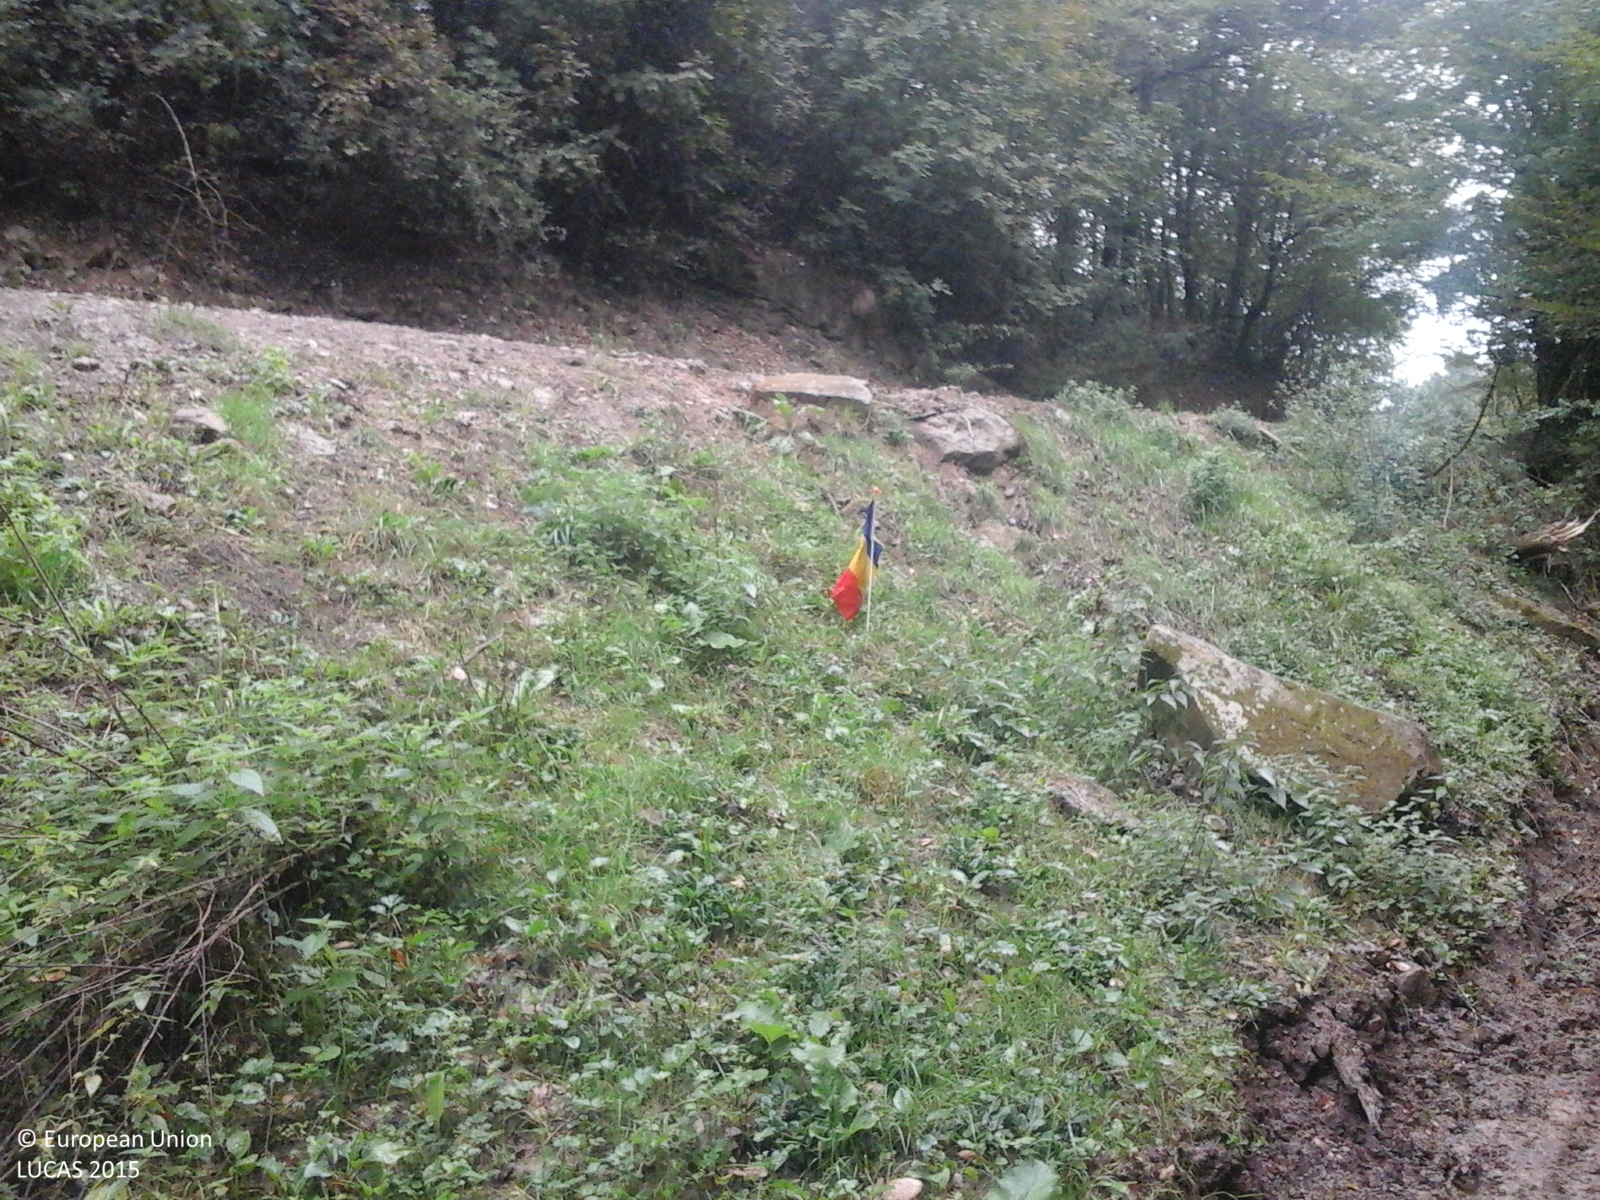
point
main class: Grassland
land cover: Grassland without tree/shrub cover
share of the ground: > 75 %
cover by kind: herbaceous plants 100 %
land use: Agriculture (excluding fallow land and kitchen gardens)
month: October
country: RO
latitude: 45.9994
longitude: 23.3749
